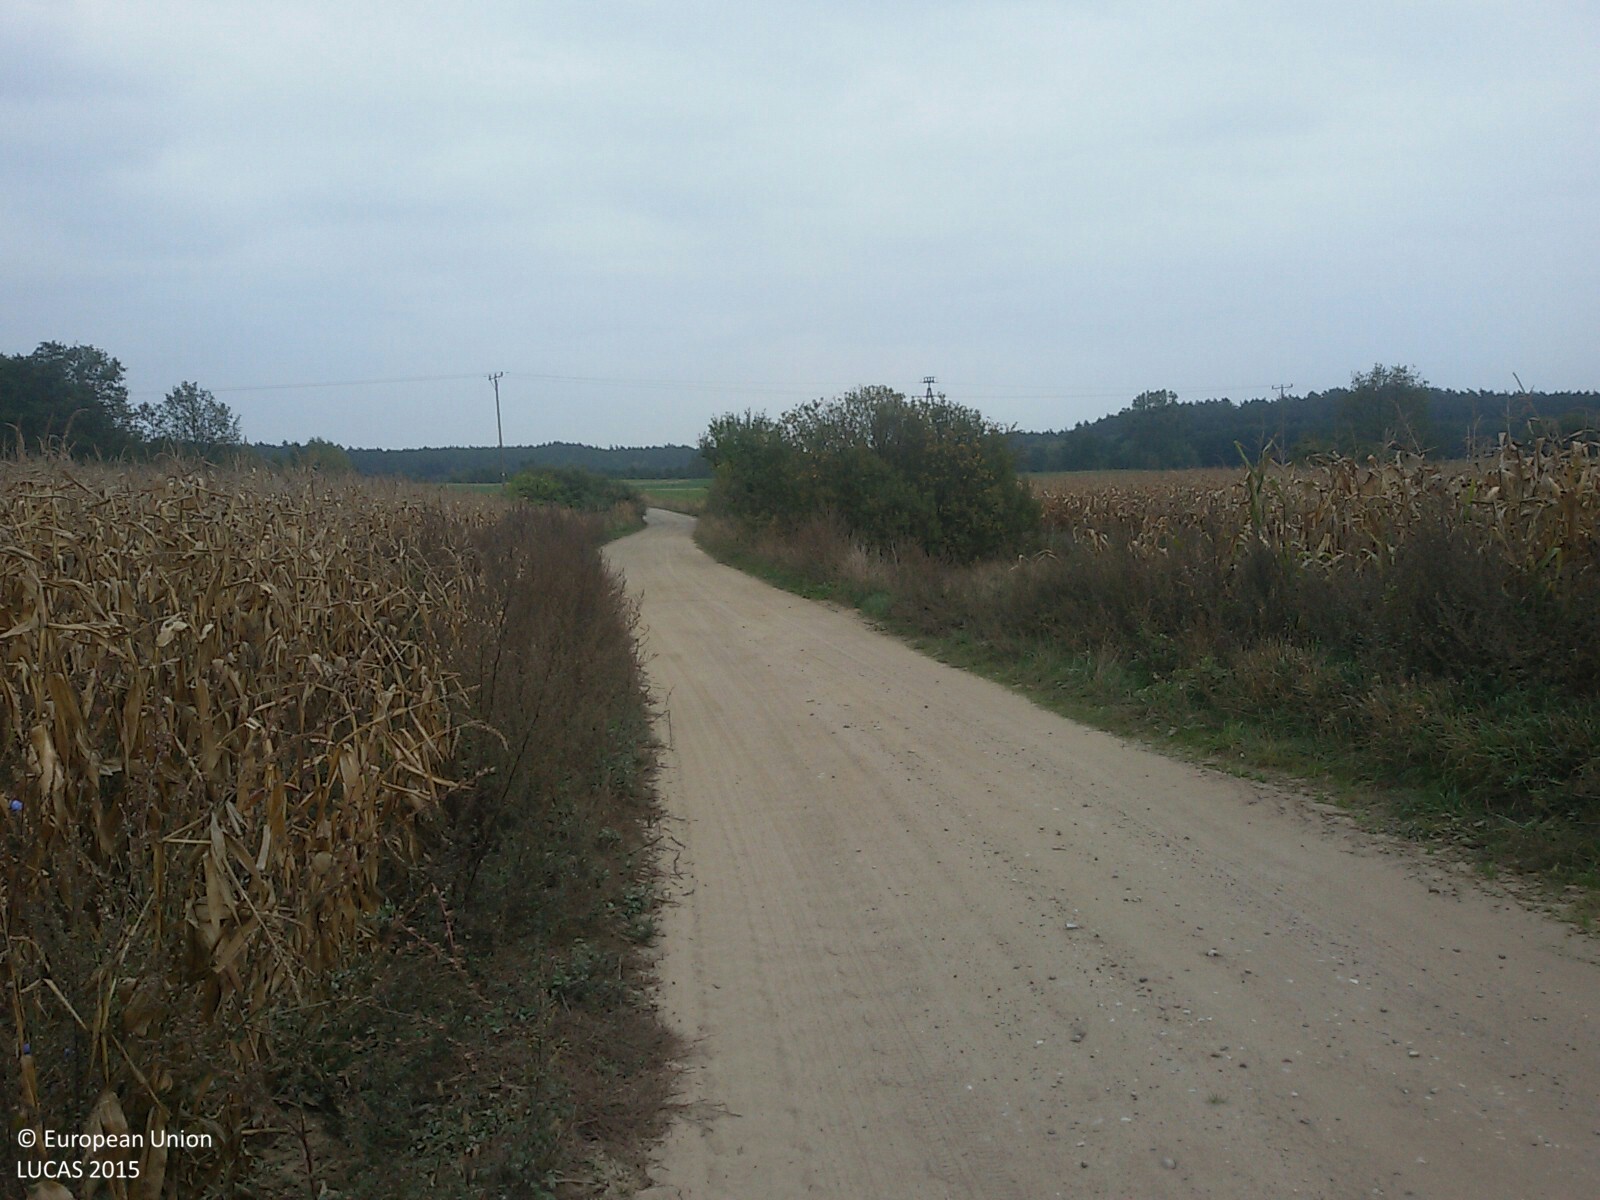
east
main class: Cropland
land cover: Maize
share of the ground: > 75 %
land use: Agriculture (excluding fallow land and kitchen gardens)
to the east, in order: Maize; Spontaneously vegetated surfaces; Grassland with sparse tree/shrub cover; Electric lines; Grassland with sparse tree/shrub cover; Tracks; Grass margins; Triticale; Rape and turnip rape
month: October
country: PL
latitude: 53.3205
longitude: 19.2268
